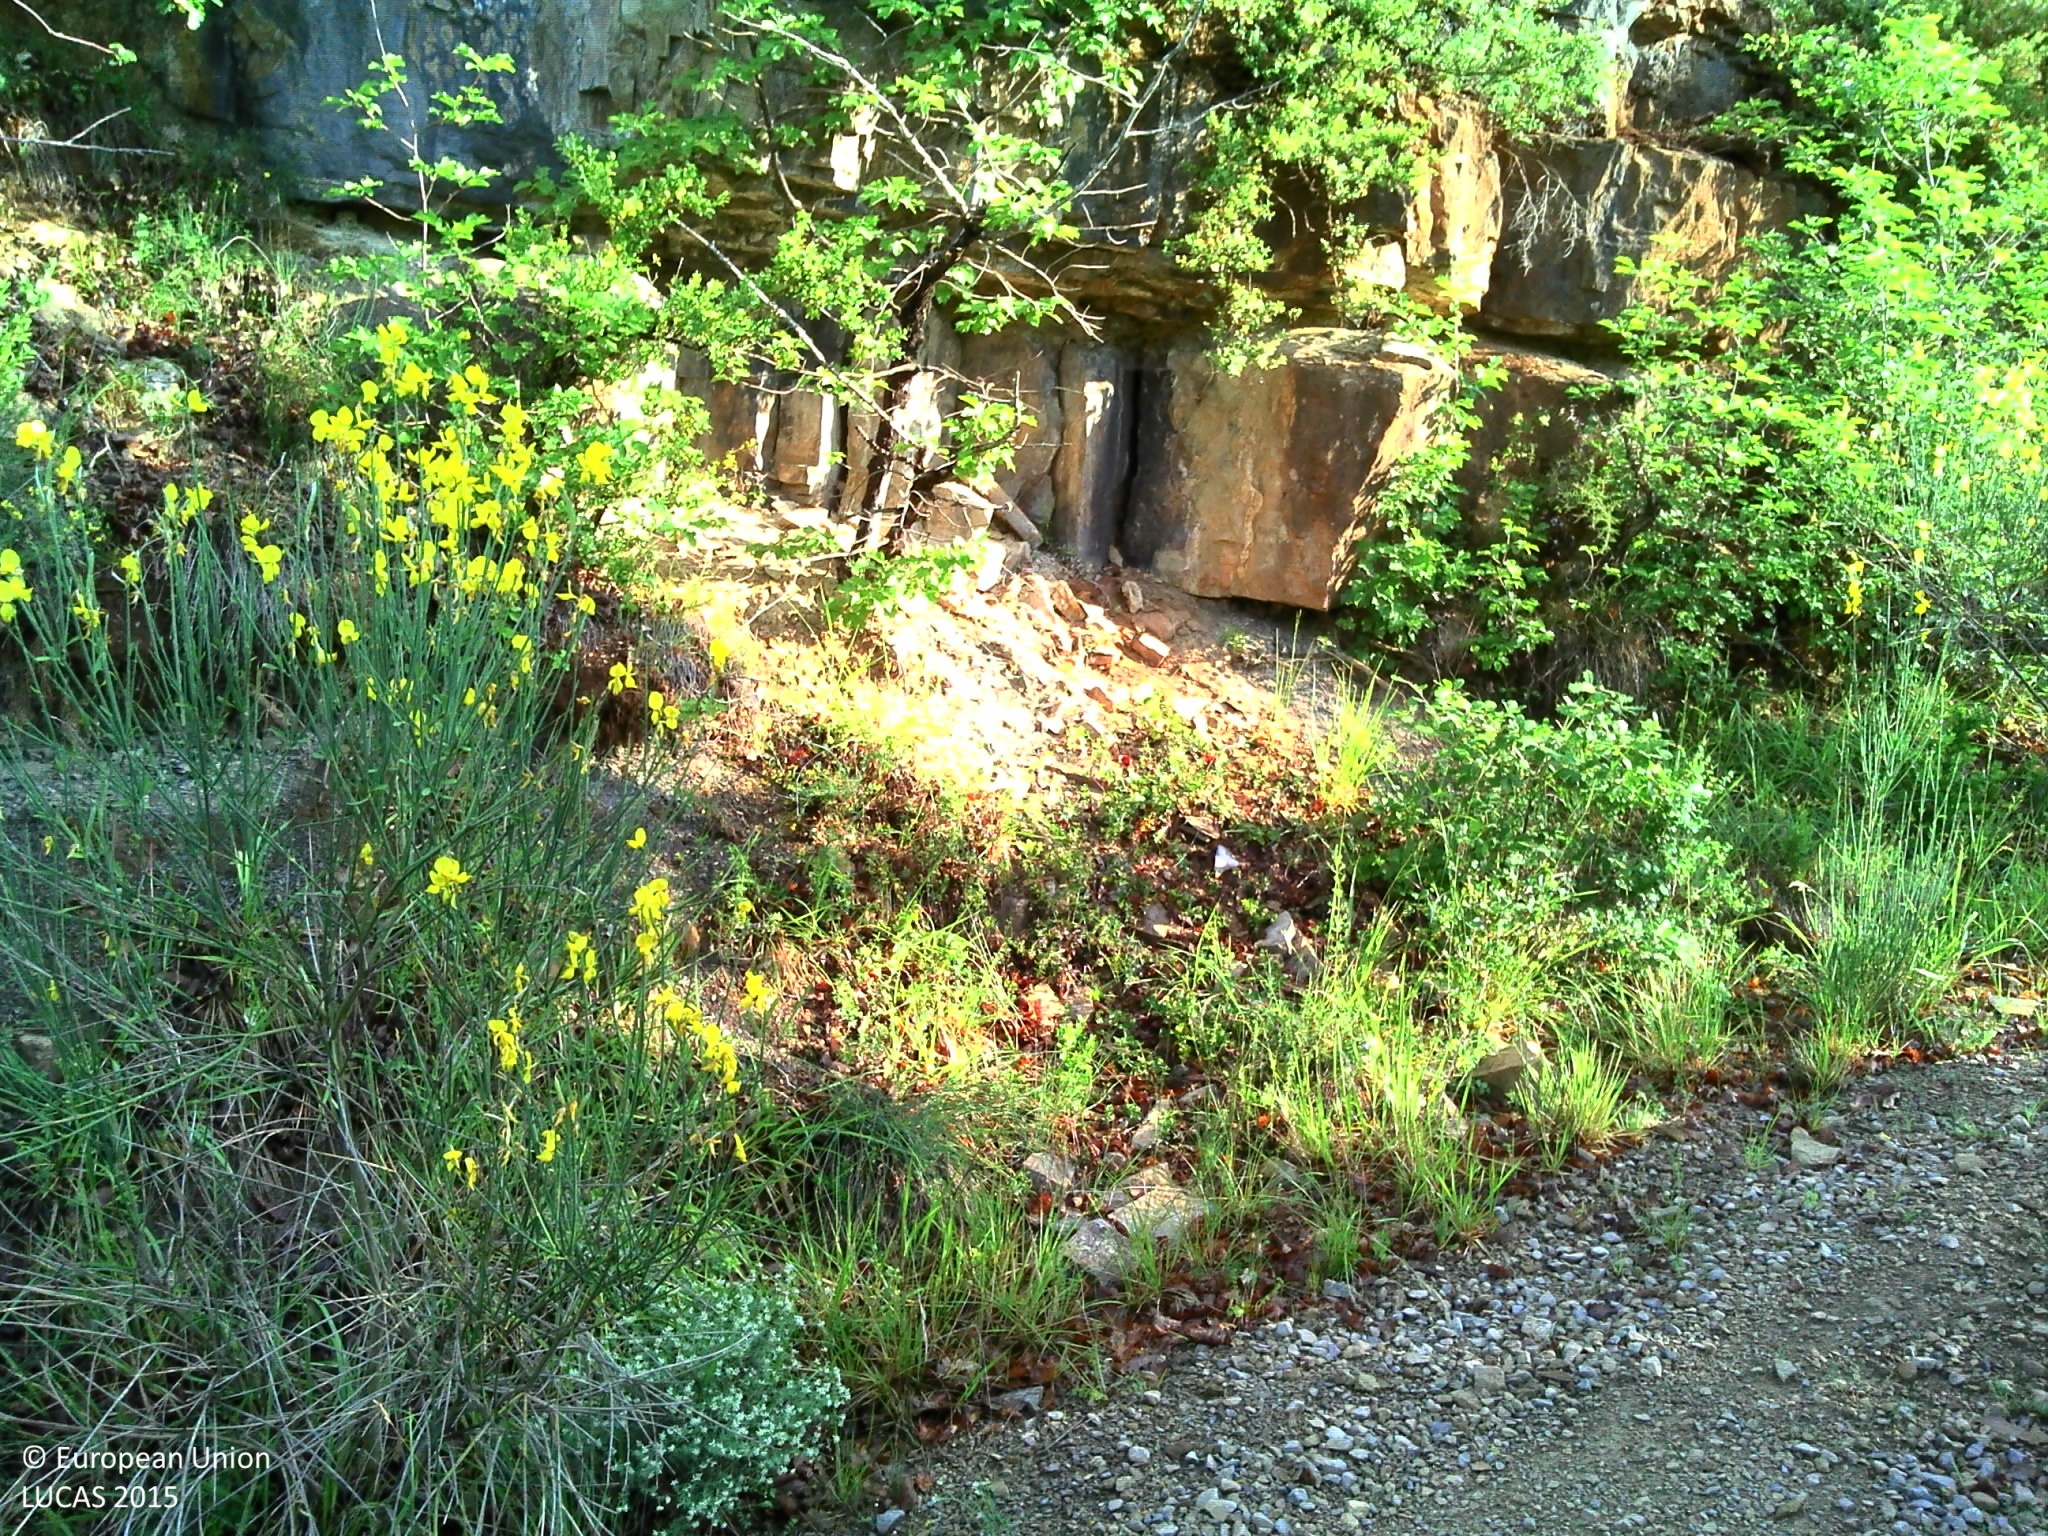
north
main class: Shrubland
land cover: Shrubland with sparse tree cover
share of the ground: > 75 %
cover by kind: shrubs 90 %, broadleaved forest trees 5 %, herbaceous plants 5 %
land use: Semi-natural and natural areas not in use
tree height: < 5 m
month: June
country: FR
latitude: 44.2102
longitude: 3.0846
